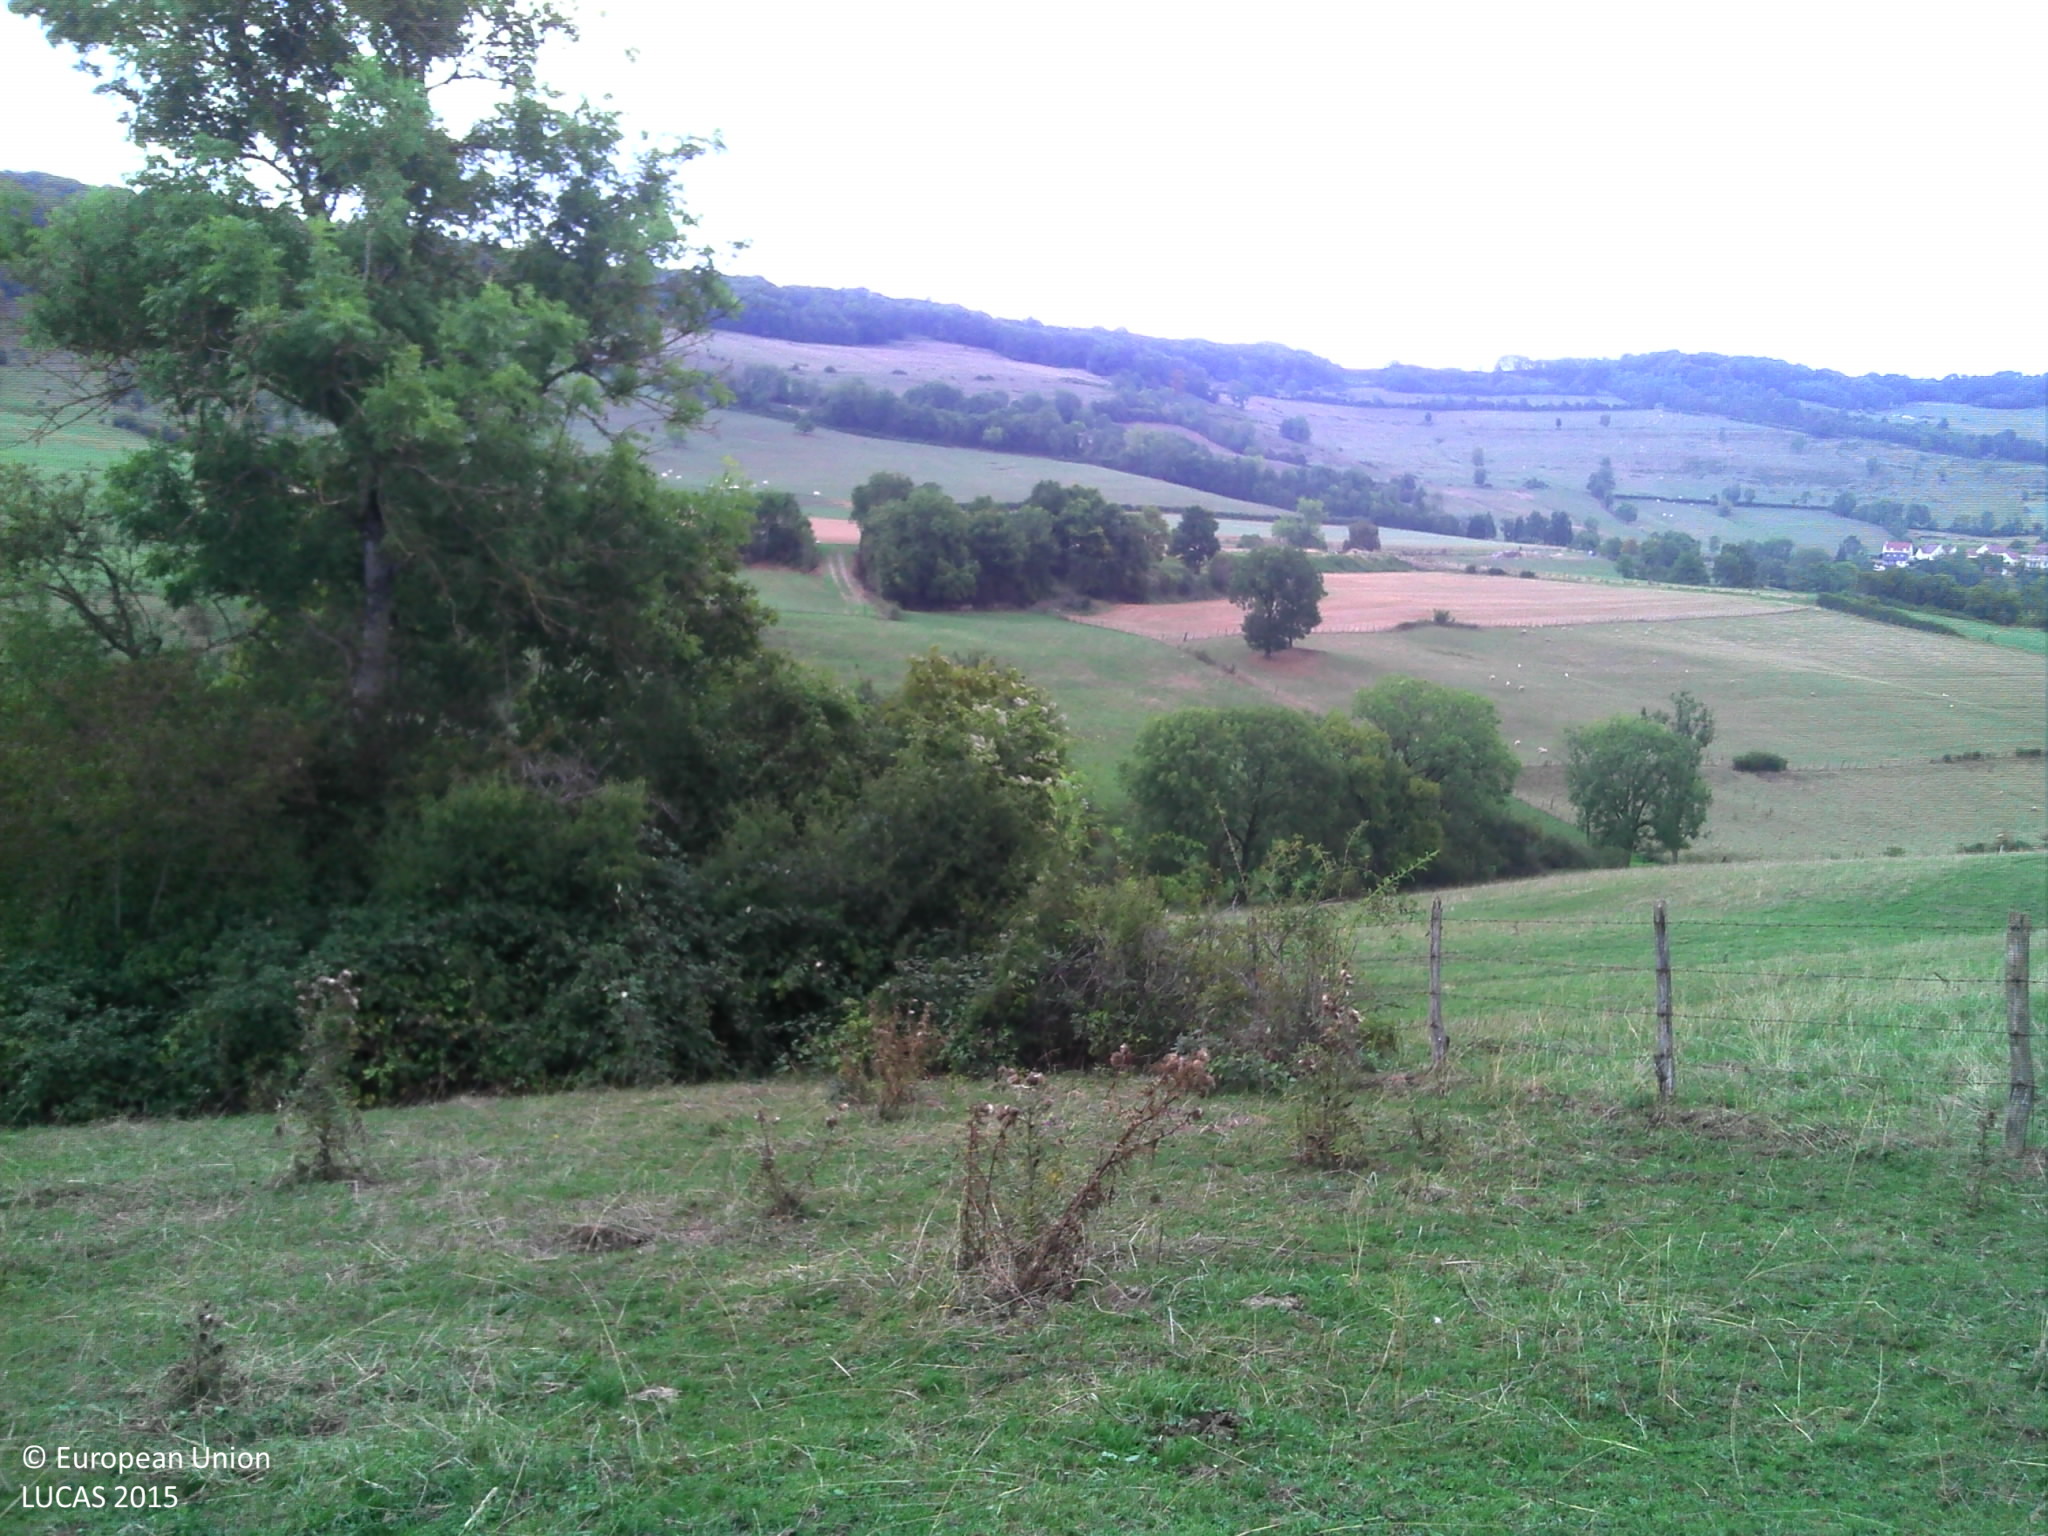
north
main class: Grassland
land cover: Grassland without tree/shrub cover
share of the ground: > 75 %
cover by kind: herbaceous plants 100 %
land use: Agriculture (excluding fallow land and kitchen gardens)
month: August
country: FR
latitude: 47.3228
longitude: 4.7473
